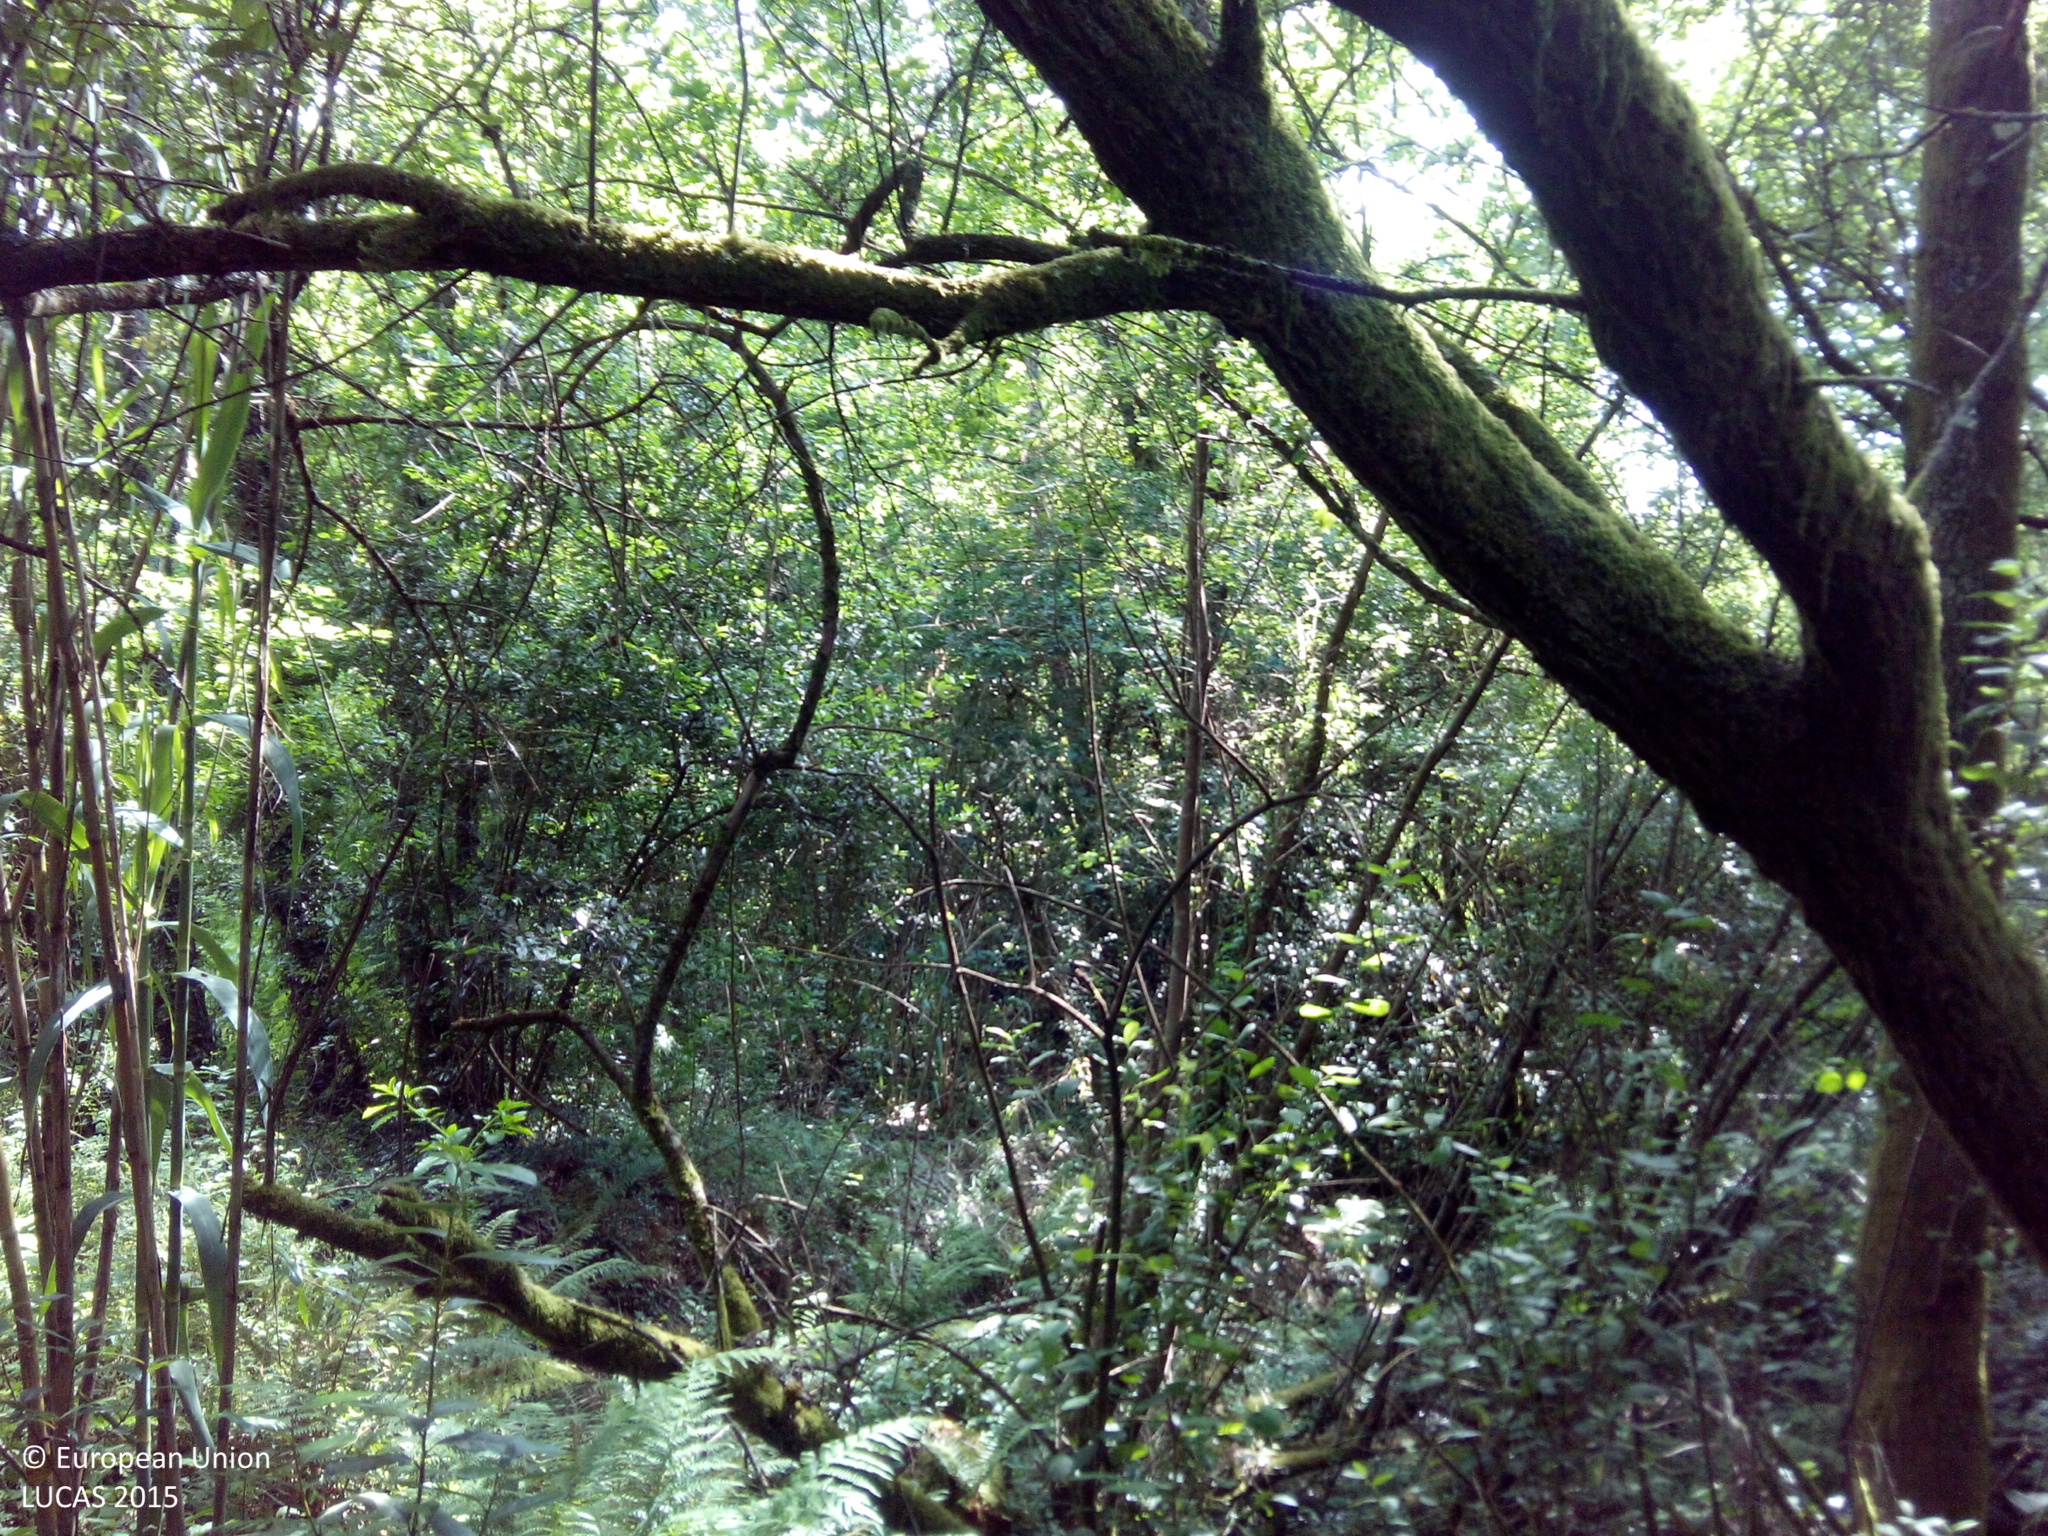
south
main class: Woodland
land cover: Broadleaved woodland
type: thermophilous deciduous forest
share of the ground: > 75 %
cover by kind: broadleaved forest trees 100 %
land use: Forestry
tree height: > 5 m
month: June
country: ES
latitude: 42.0996
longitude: -8.3836
